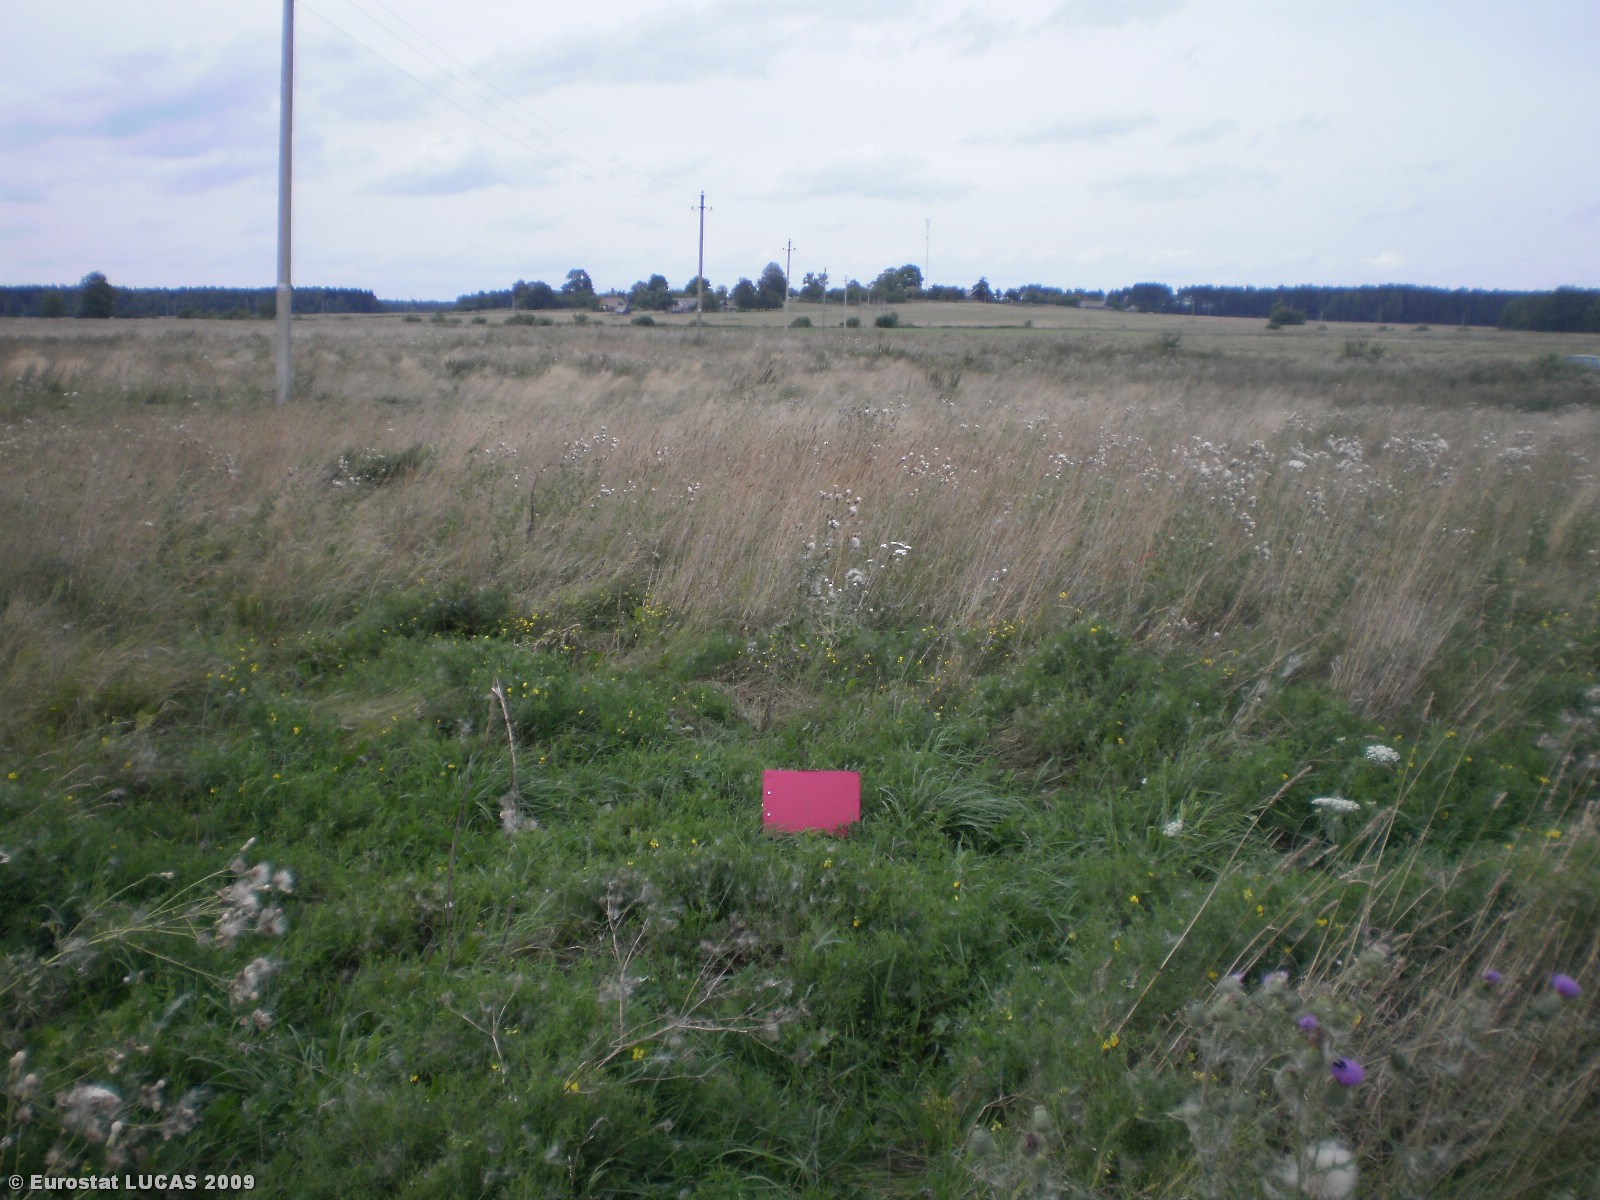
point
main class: Grassland
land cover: Grassland without tree/shrub cover
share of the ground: > 75 %
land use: Agriculture (excluding fallow land and kitchen gardens)
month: August
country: LT
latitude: 54.9954
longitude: 24.6260
